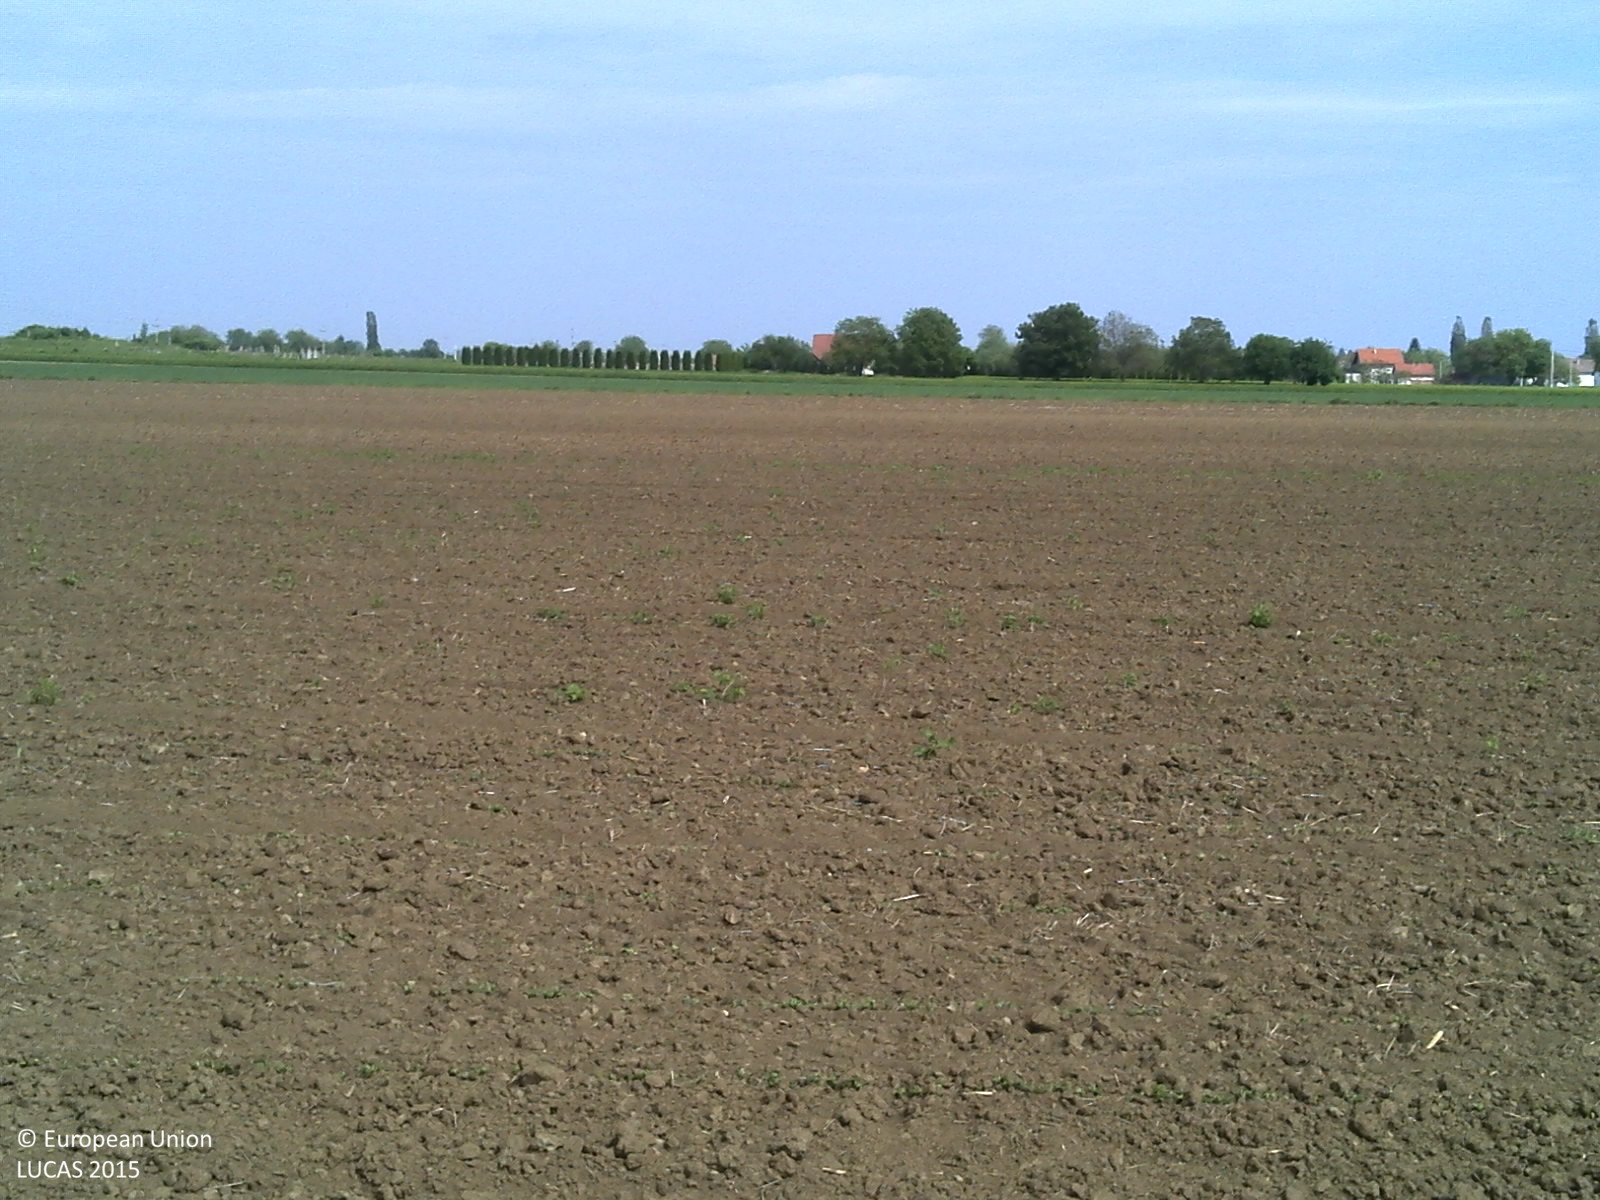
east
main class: Cropland
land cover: Soya
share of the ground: < 10 %
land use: Agriculture (excluding fallow land and kitchen gardens)
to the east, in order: Soya; Other bare soil; Soya; Tracks; Common wheat
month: May
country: HR
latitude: 45.1847
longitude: 19.0827
